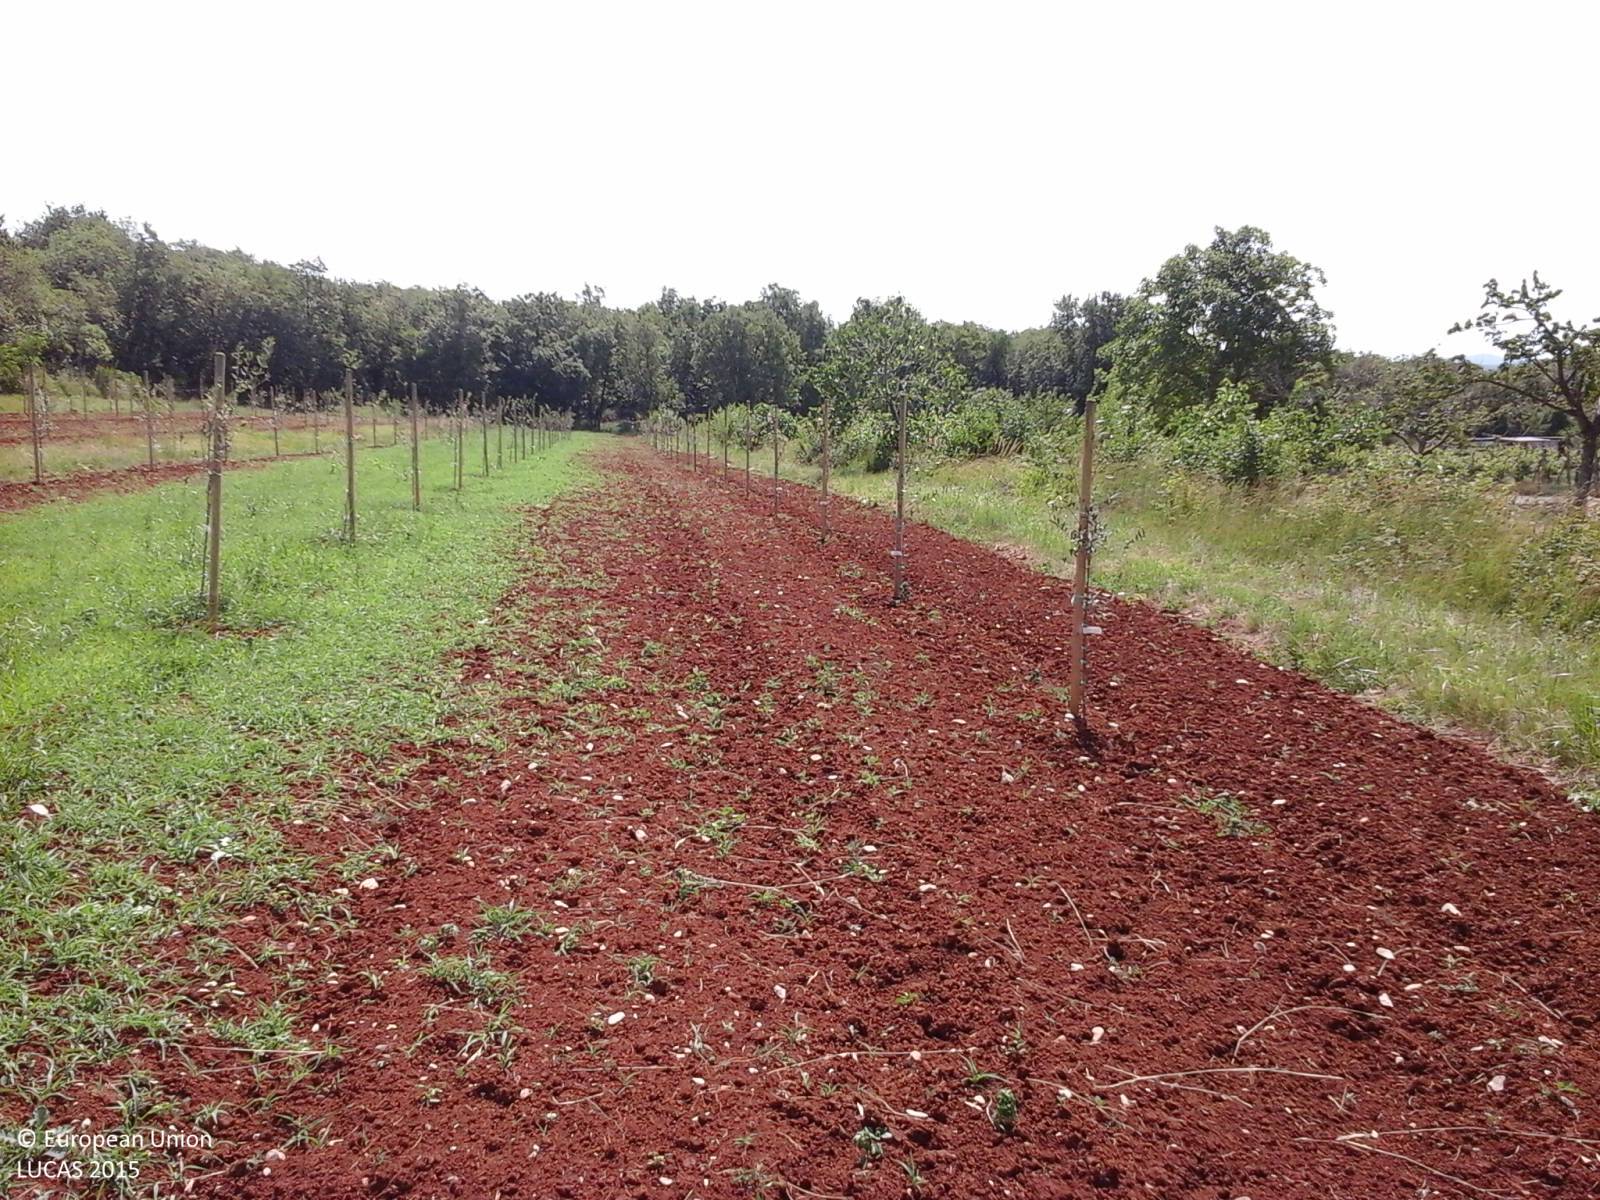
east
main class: Cropland
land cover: Olive groves
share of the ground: 25 - 50 %
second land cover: Grassland without tree/shrub cover
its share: 10 - 25 %
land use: Agriculture (excluding fallow land and kitchen gardens)
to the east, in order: Olive groves; Grassland without tree/shrub cover; Dry stone walls; Broadleaved woodland; Shrubland with sparse tree cover
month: June
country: IT
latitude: 45.8780
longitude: 13.5392
